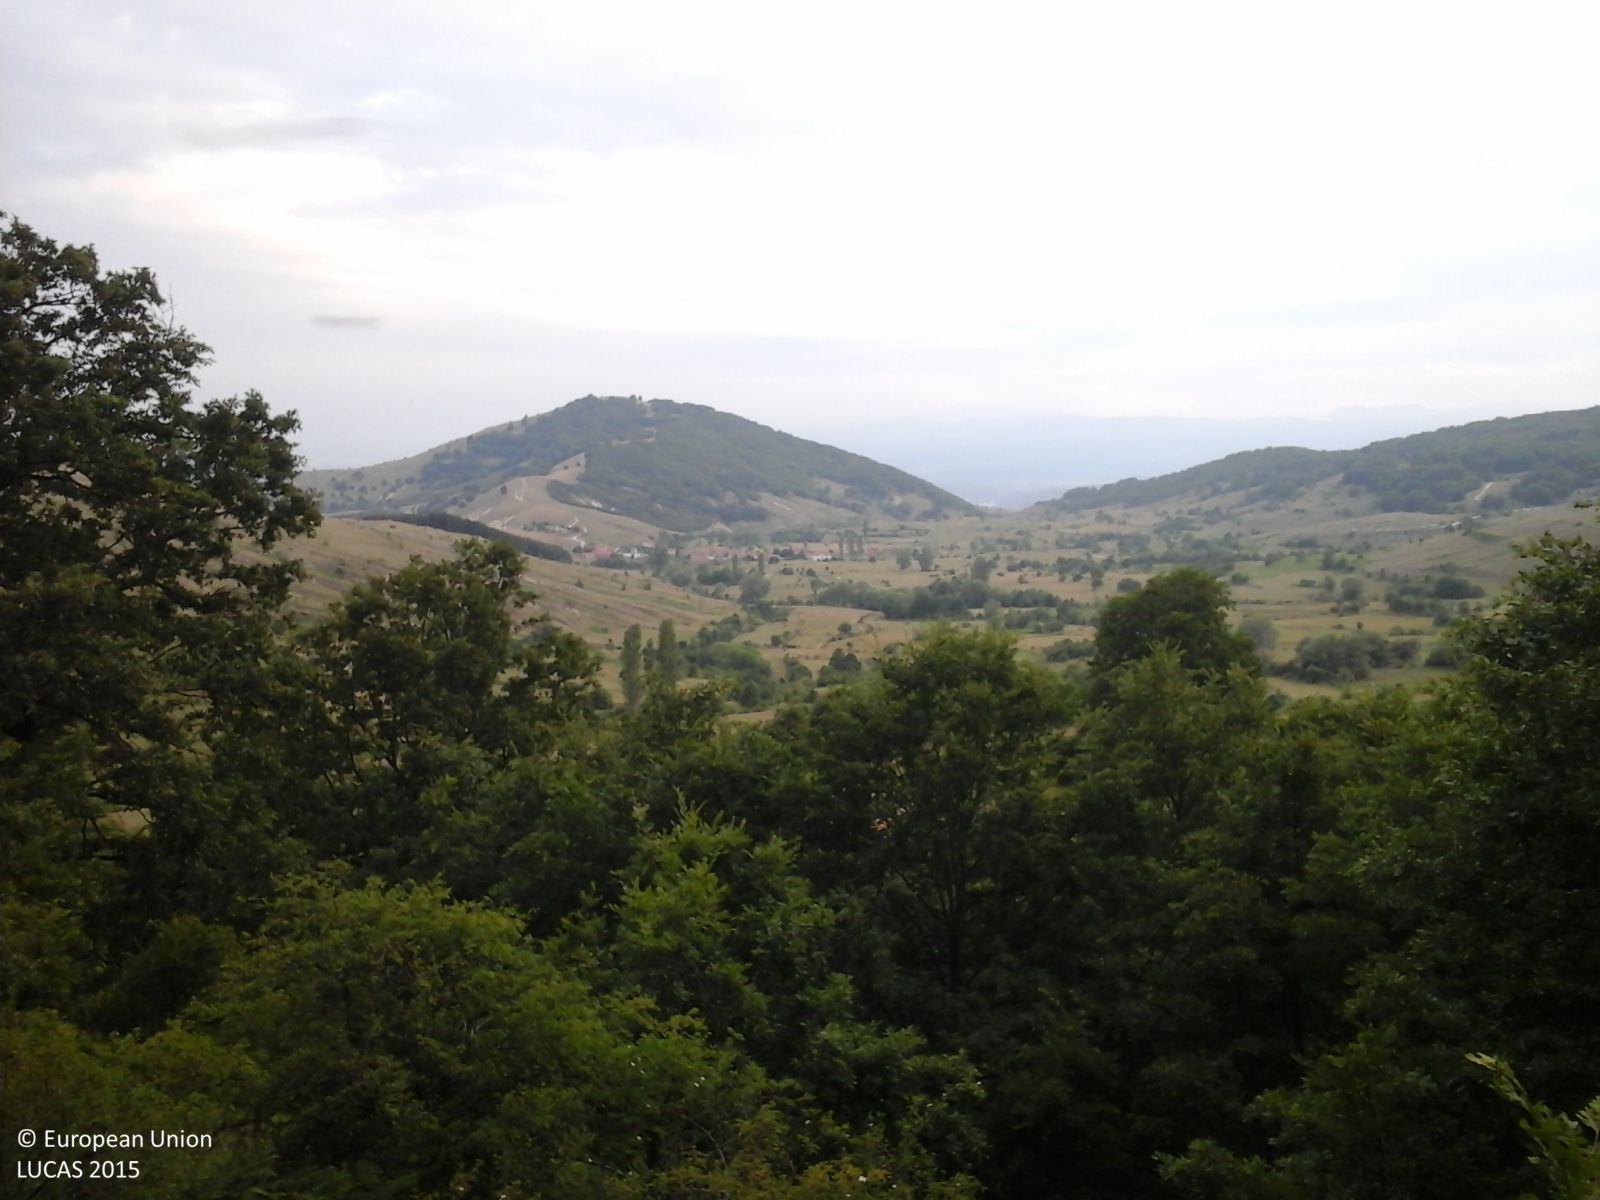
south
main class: Woodland
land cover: Broadleaved woodland
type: thermophilous deciduous forest
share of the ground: 50 - 75 %
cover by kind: broadleaved forest trees 50 %, herbaceous plants 50 %
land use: Forestry
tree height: > 5 m
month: June
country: GR
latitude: 40.6074
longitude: 21.3731
